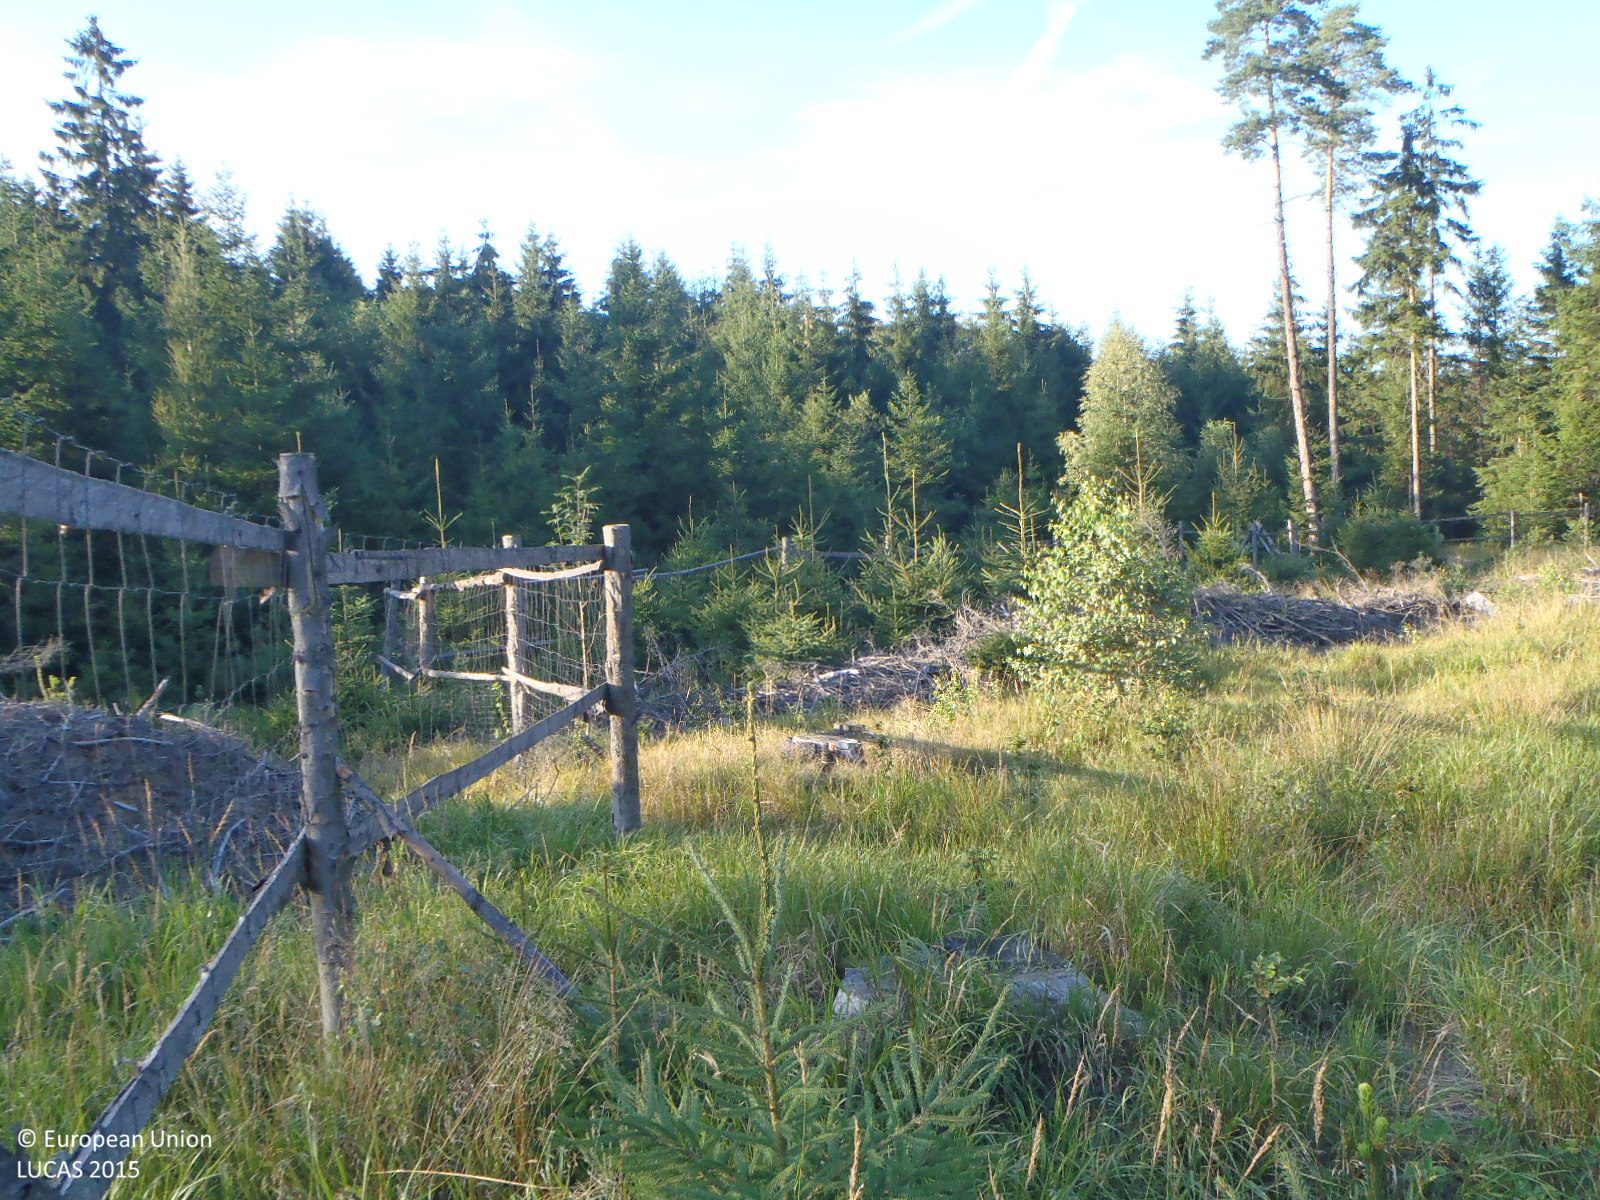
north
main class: Woodland
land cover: Other mixed woodland
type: hemiboreal forest and nemoral coniferous forest and mixed broadleaved-coniferous forest
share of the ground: 50 - 75 %
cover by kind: herbaceous plants 45 %, coniferous forest trees 25 %, broadleaved forest trees 25 %, shrubs 5 %
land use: Forestry
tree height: < 5 m
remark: Nursery
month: August
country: CZ
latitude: 50.8685
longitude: 14.5347
